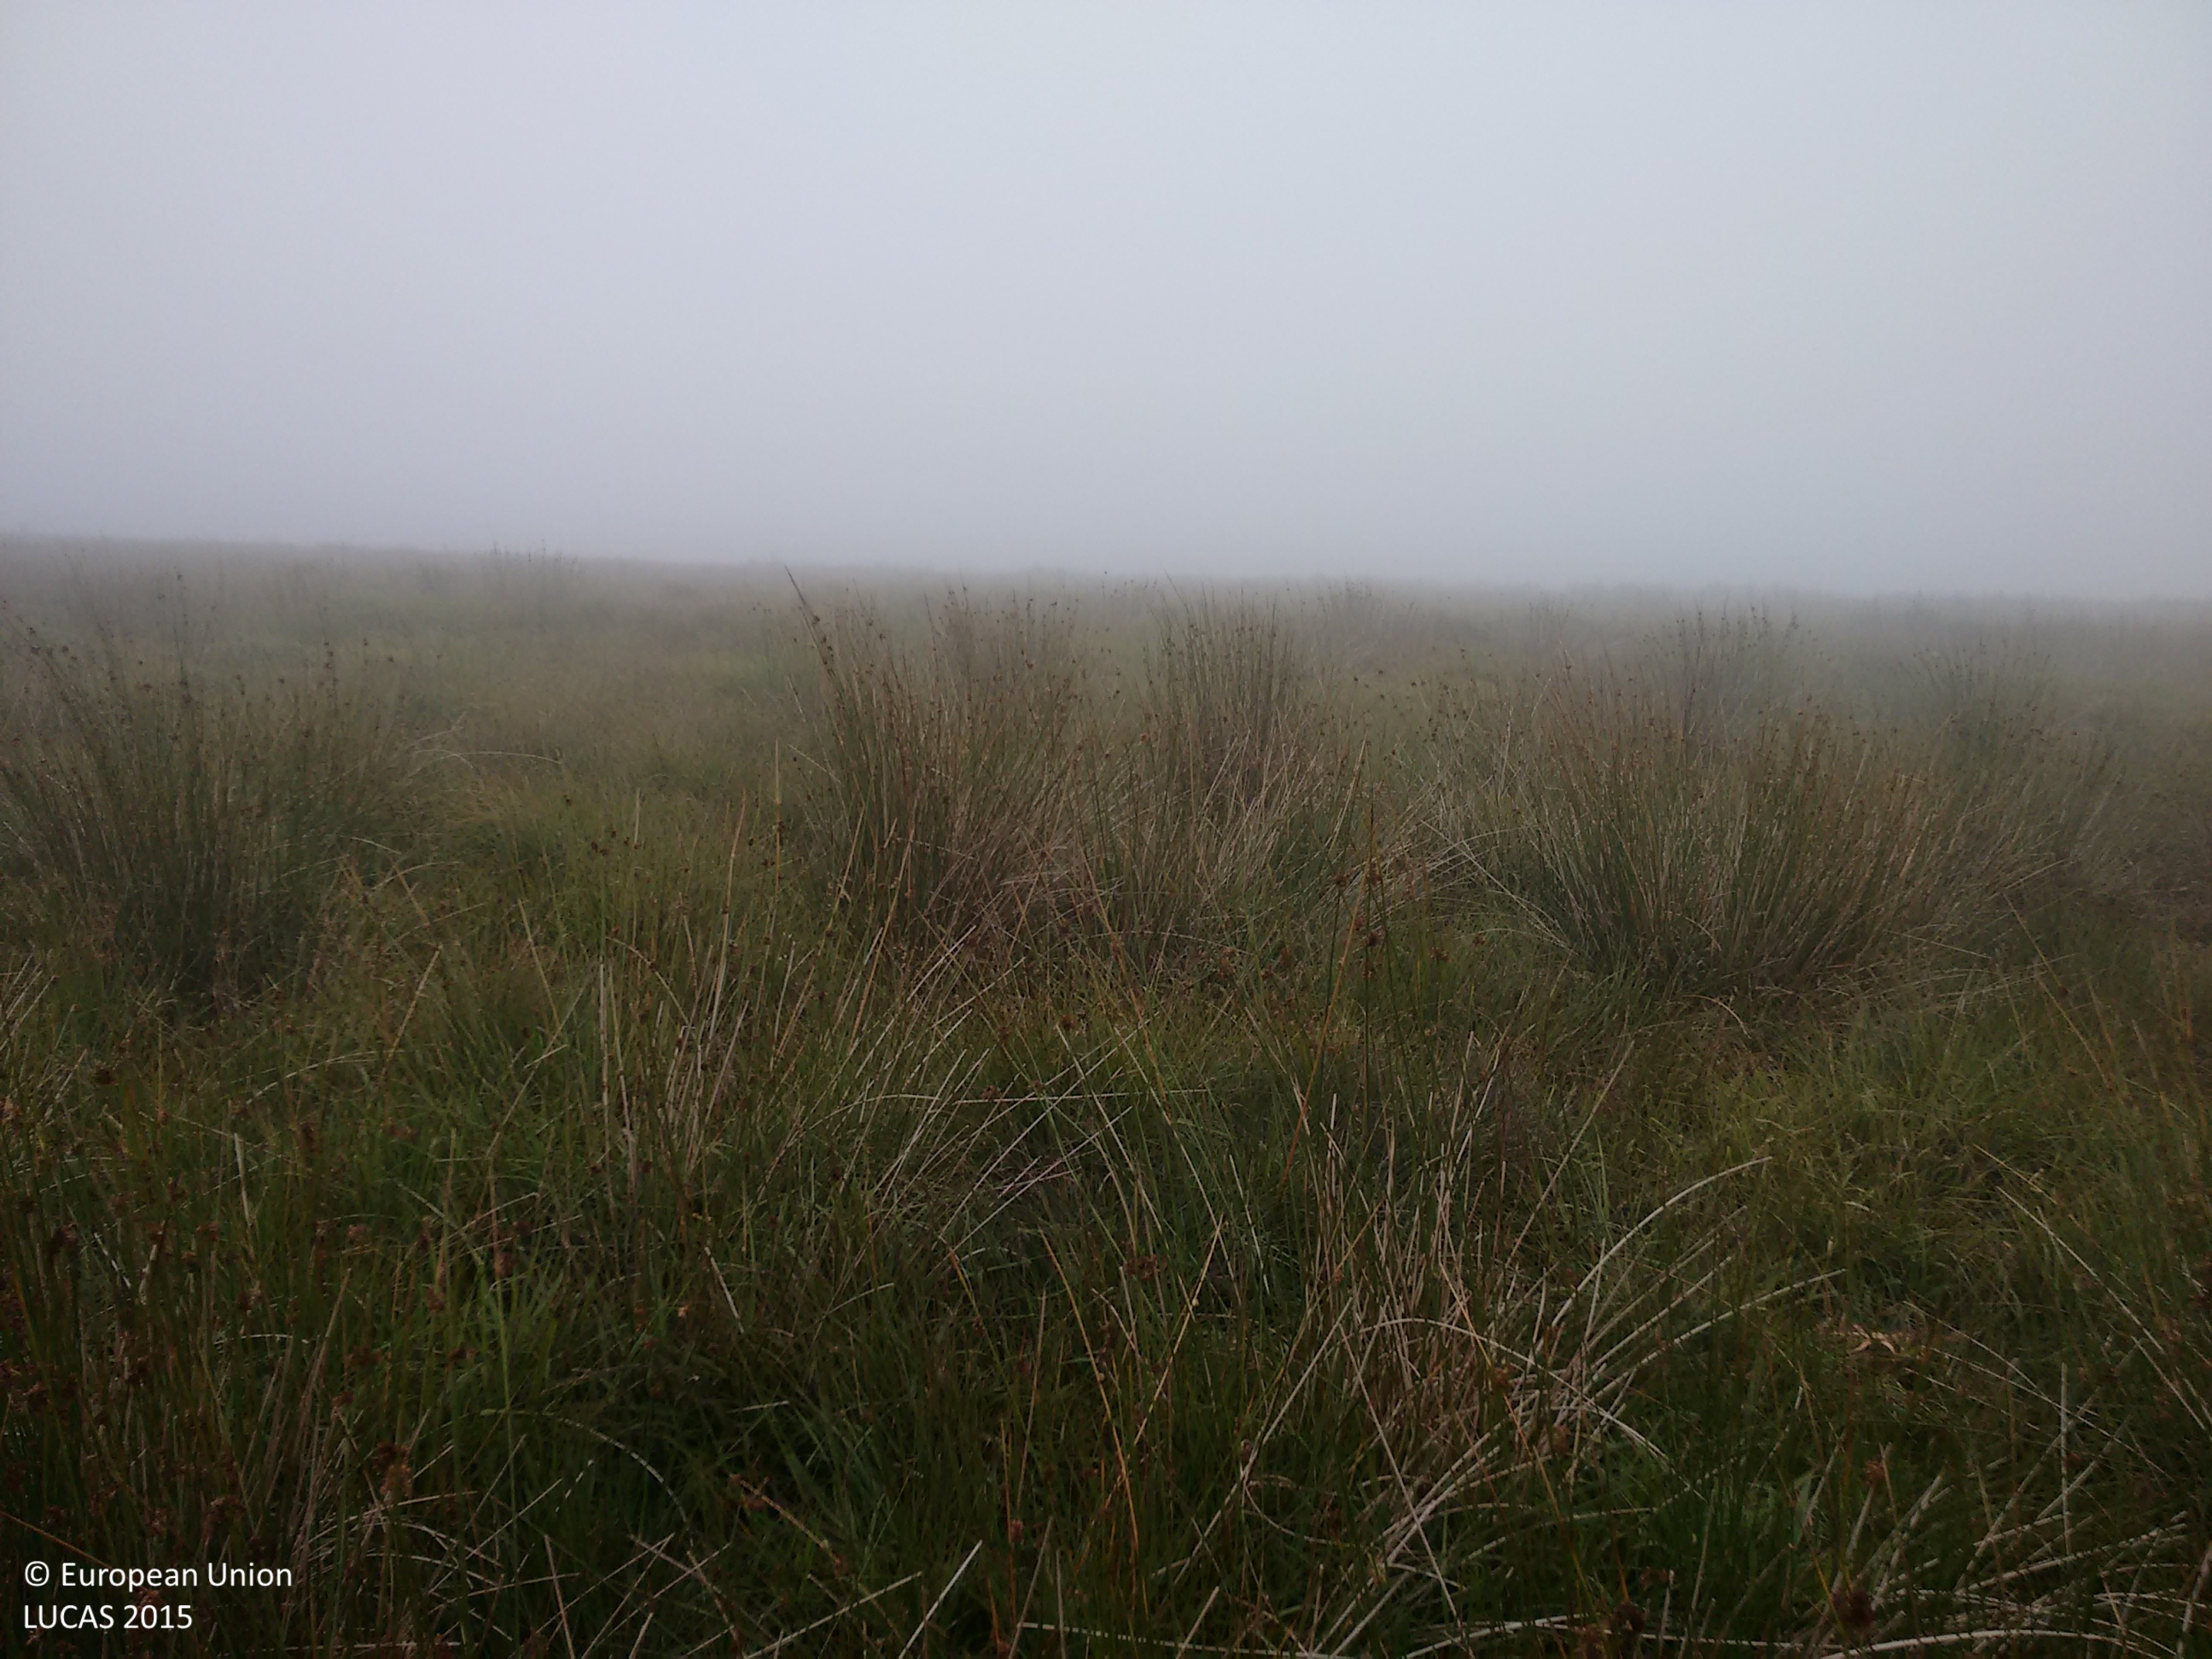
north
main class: Grassland
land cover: Grassland without tree/shrub cover
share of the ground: > 75 %
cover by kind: herbaceous plants 100 %
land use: Agriculture (excluding fallow land and kitchen gardens)
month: August
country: GB
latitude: 51.1114
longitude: -3.7884
